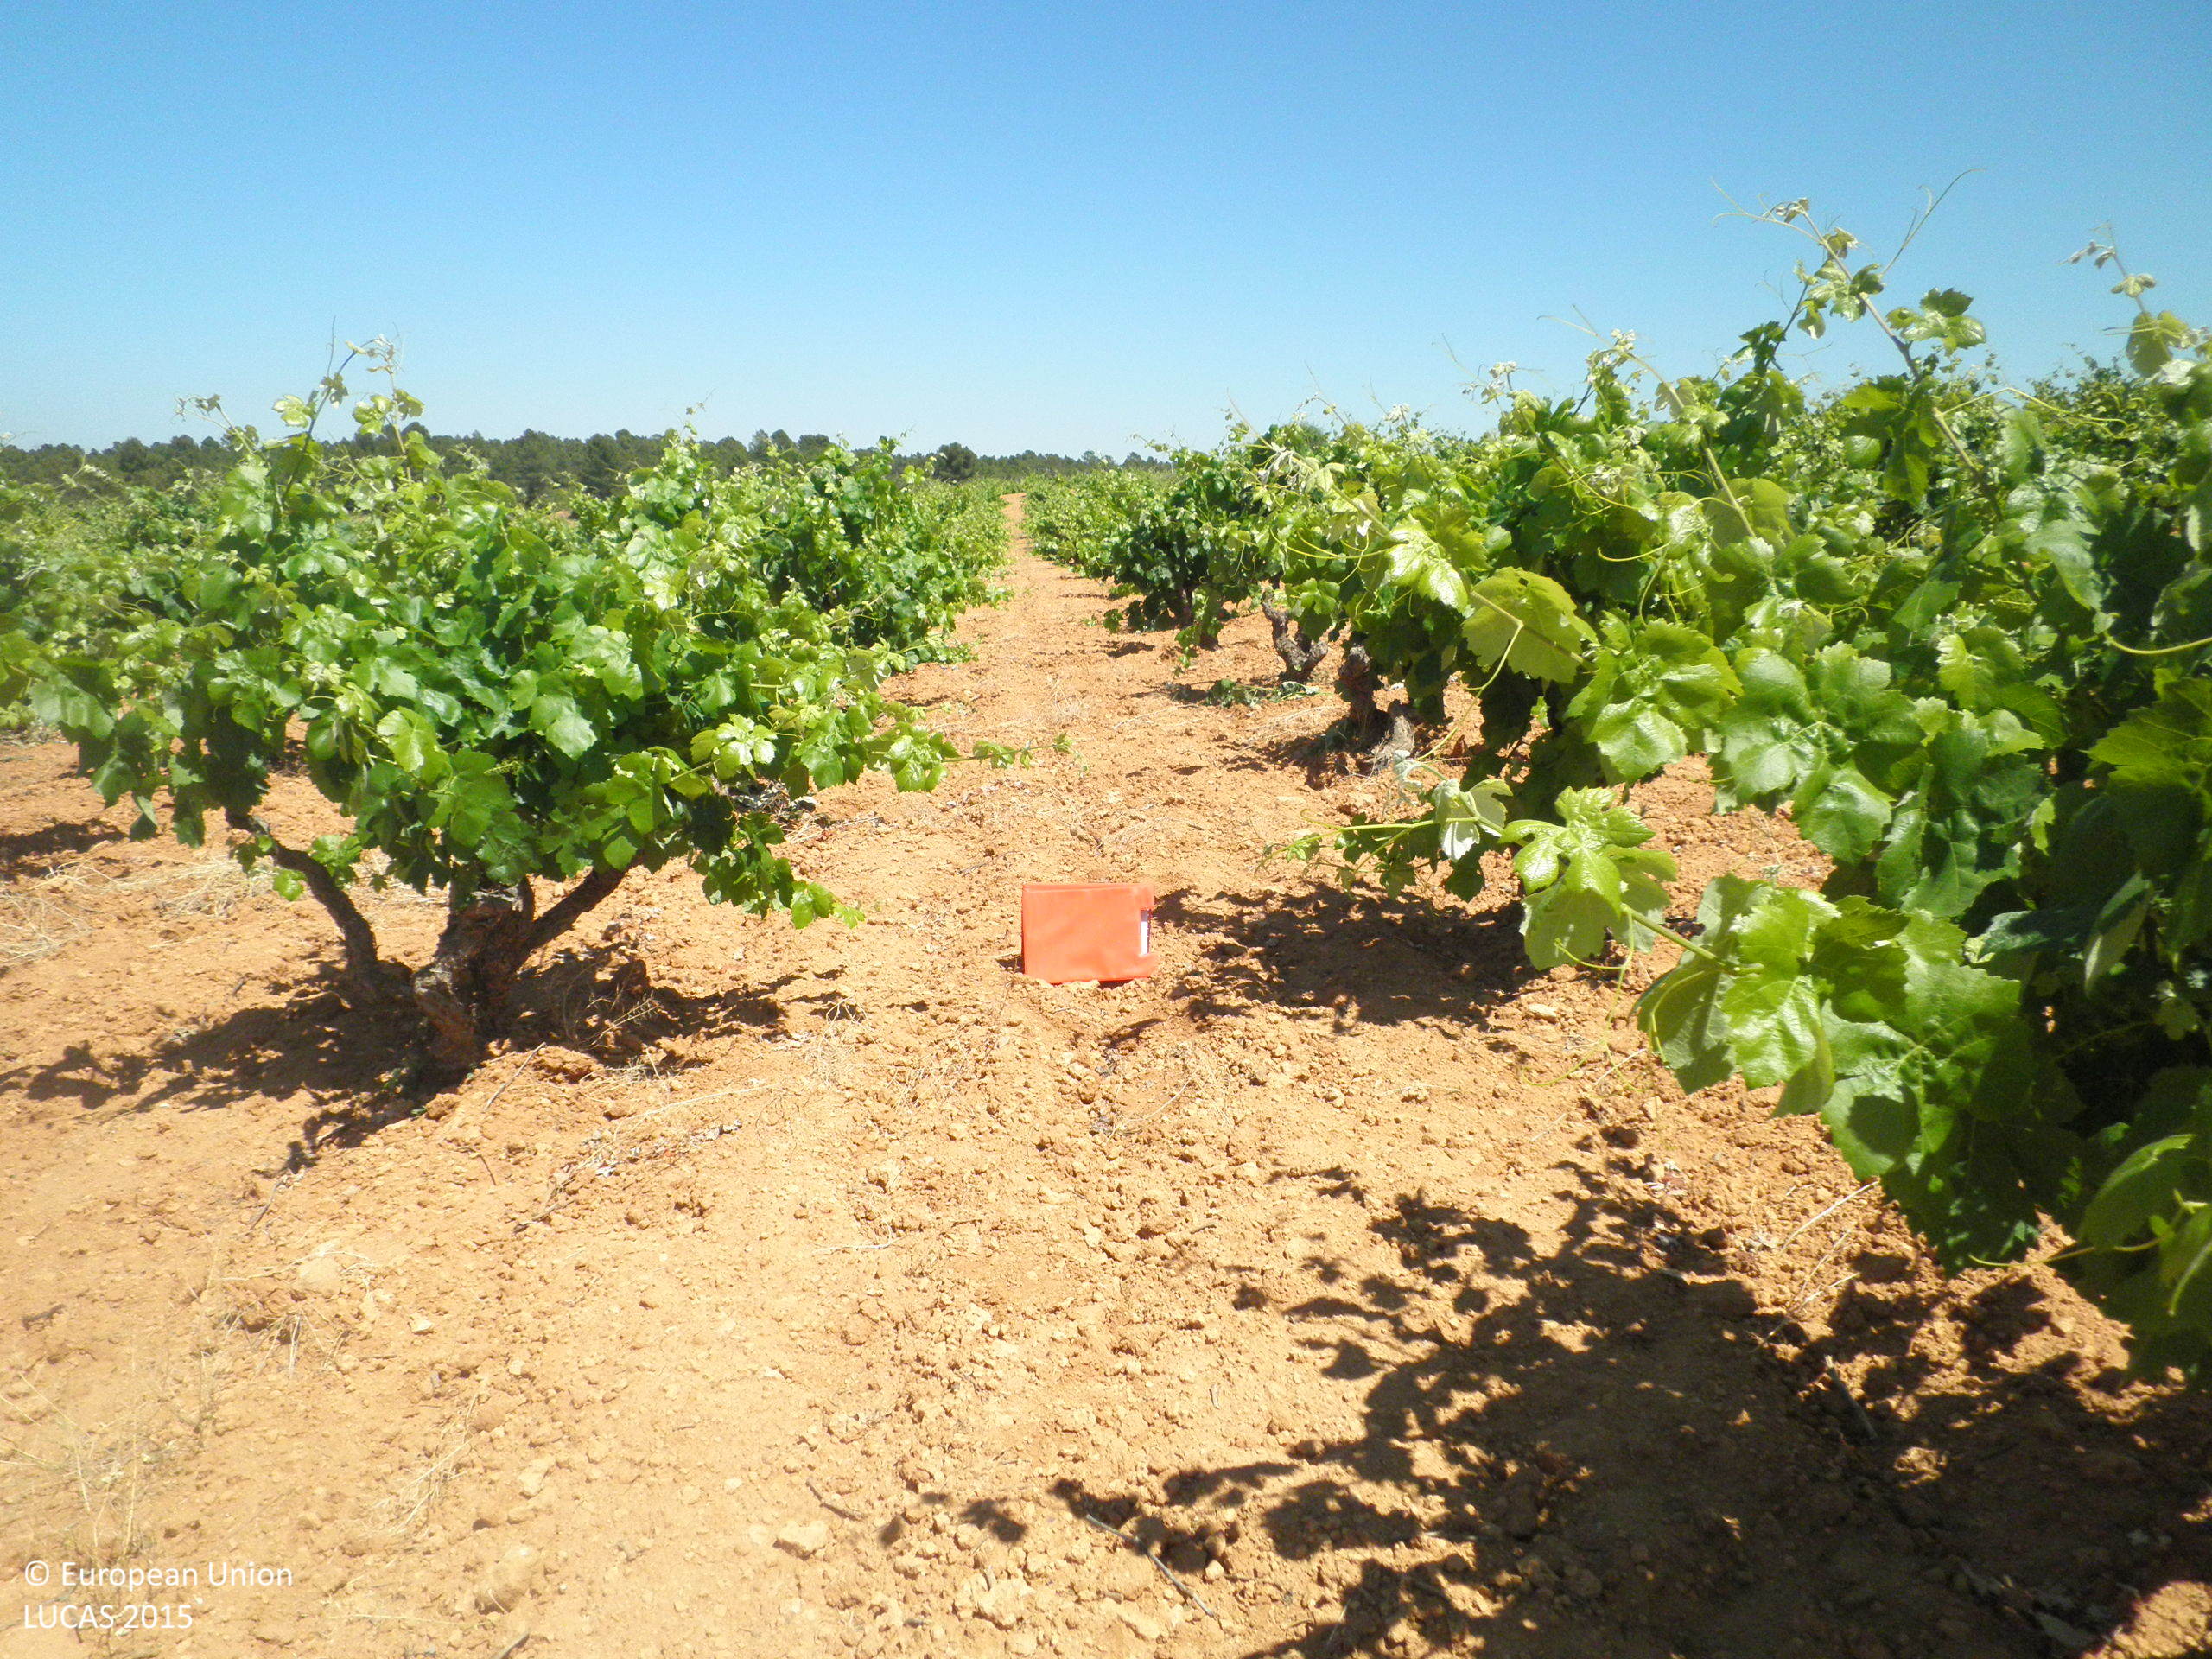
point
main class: Cropland
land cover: Vineyards
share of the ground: 10 - 25 %
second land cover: Other bare soil
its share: > 75 %
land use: Agriculture (excluding fallow land and kitchen gardens)
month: June
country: ES
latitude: 39.5162
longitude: -1.6485
